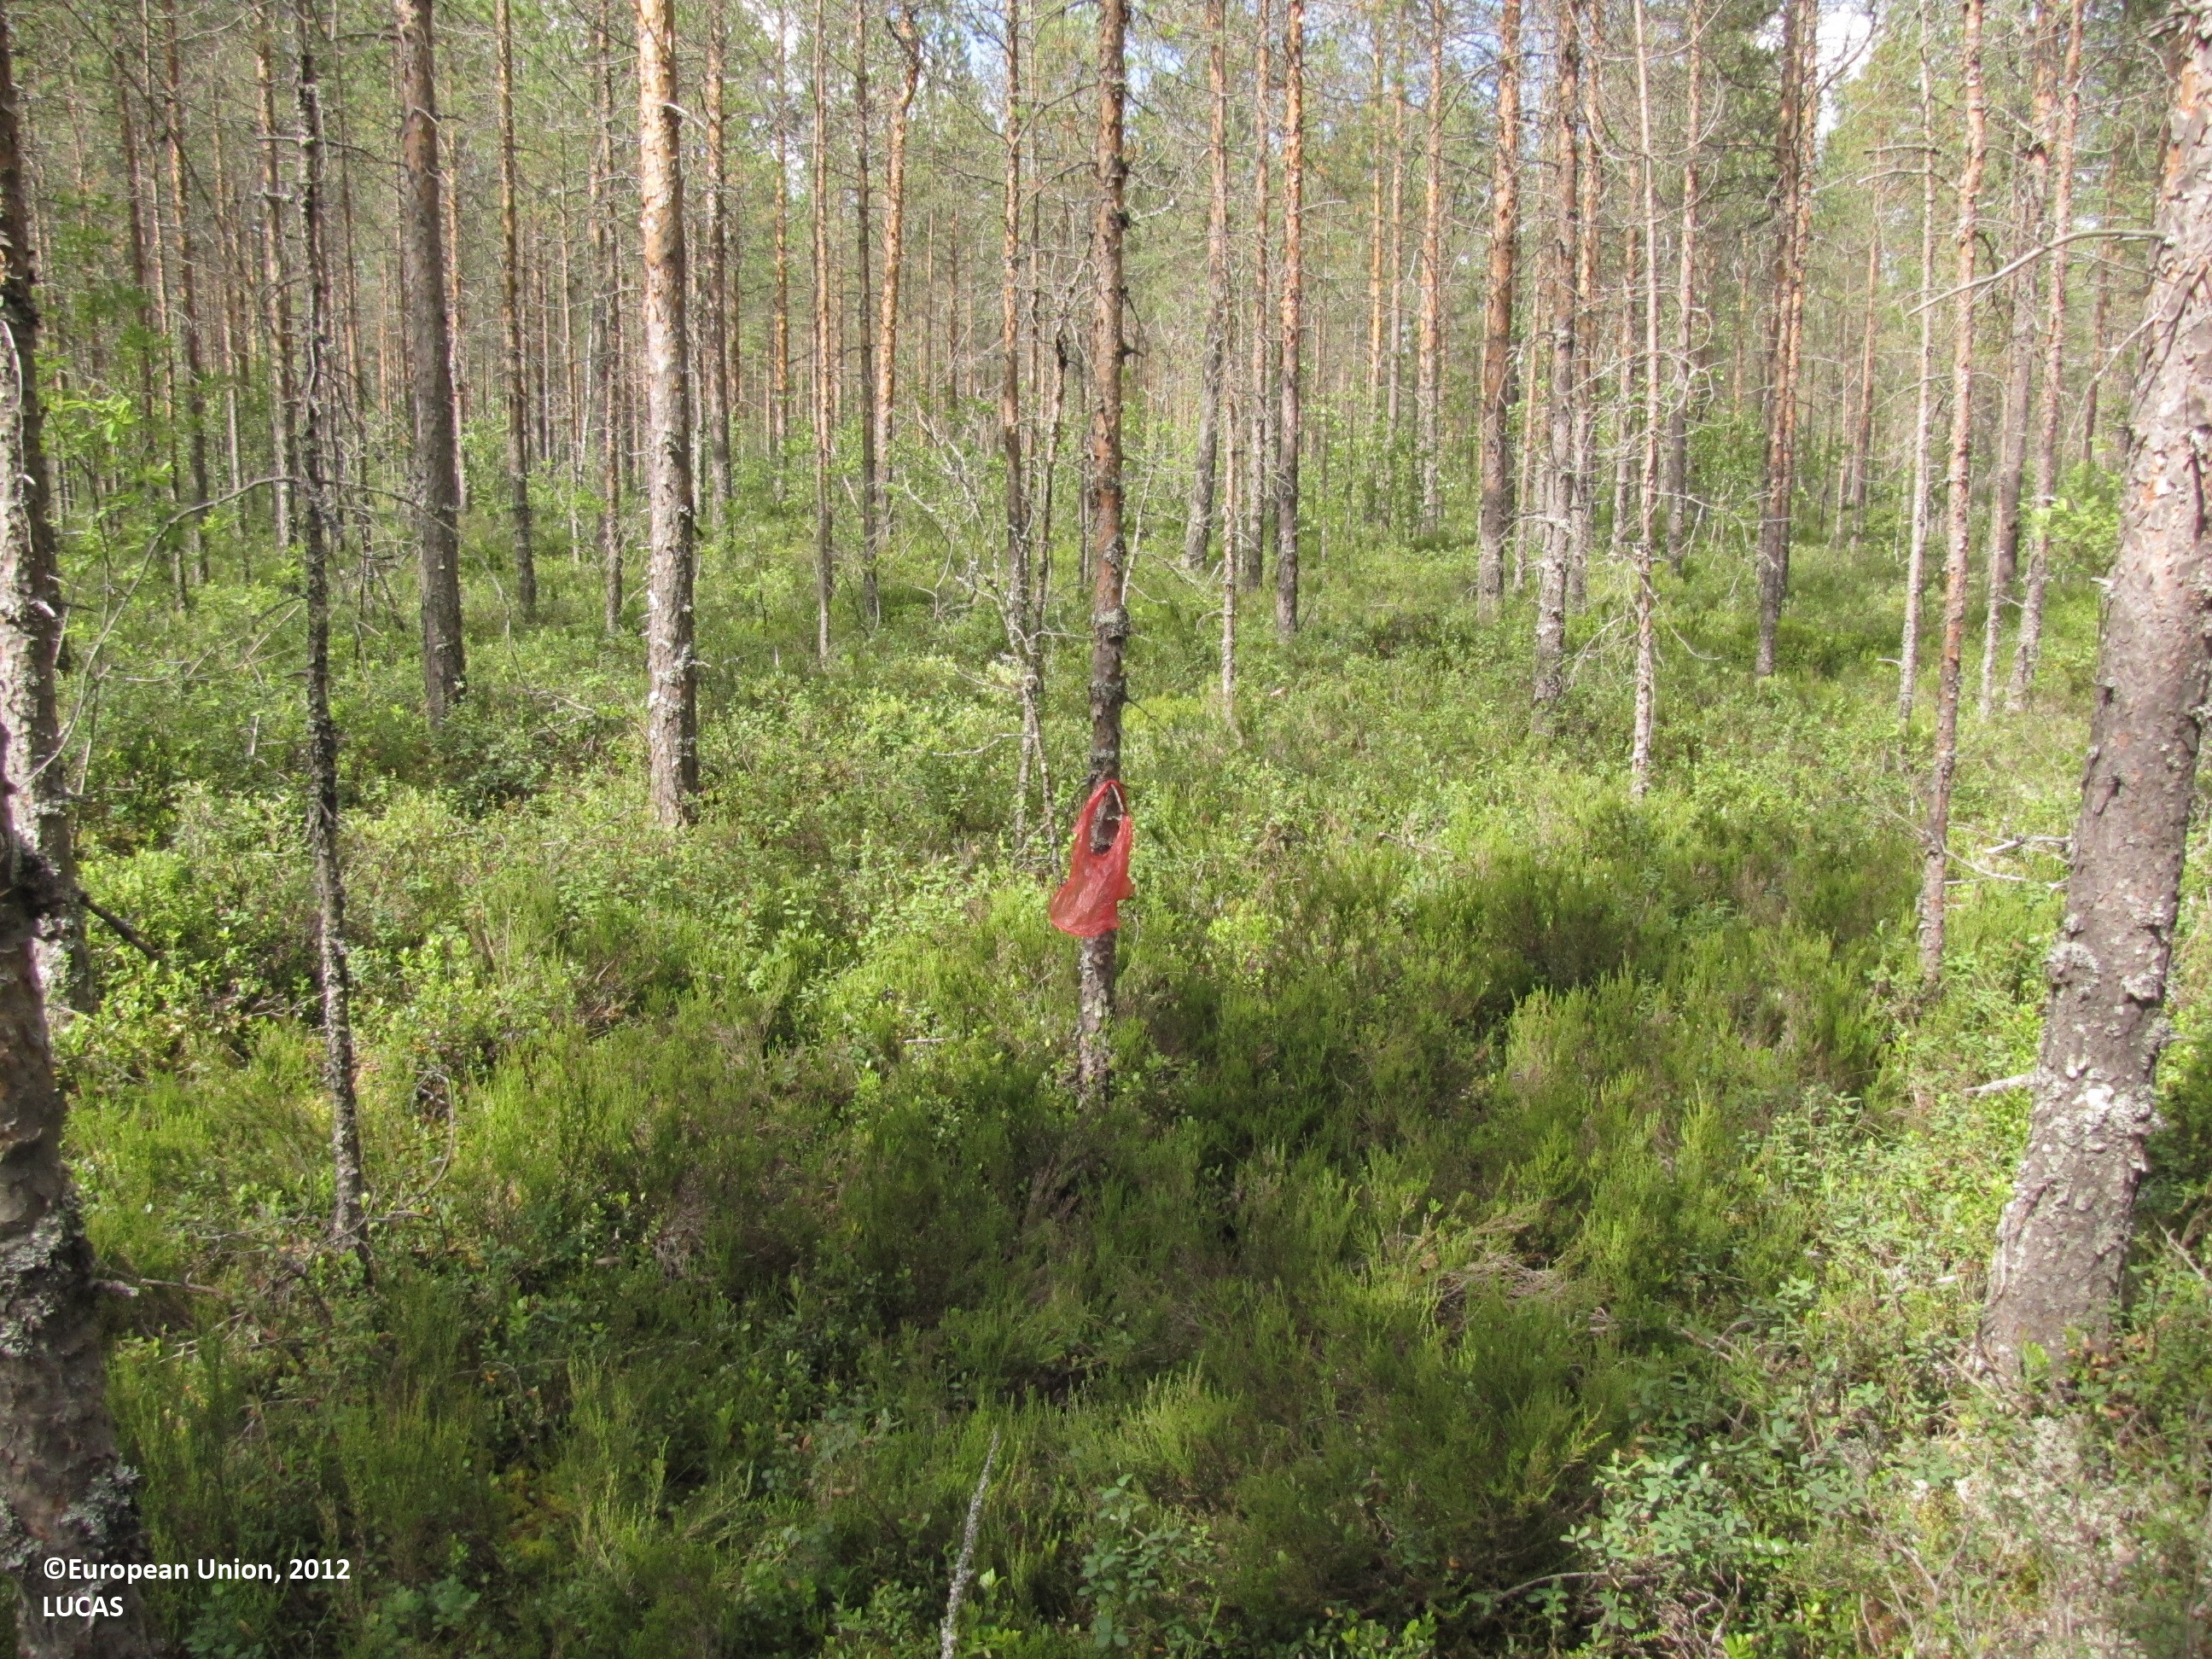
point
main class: Woodland
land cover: Pine dominated coniferous woodland
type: mire and swamp forests
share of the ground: > 75 %
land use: Forestry
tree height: > 5 m
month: July
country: FI
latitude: 62.4474
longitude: 23.2249
